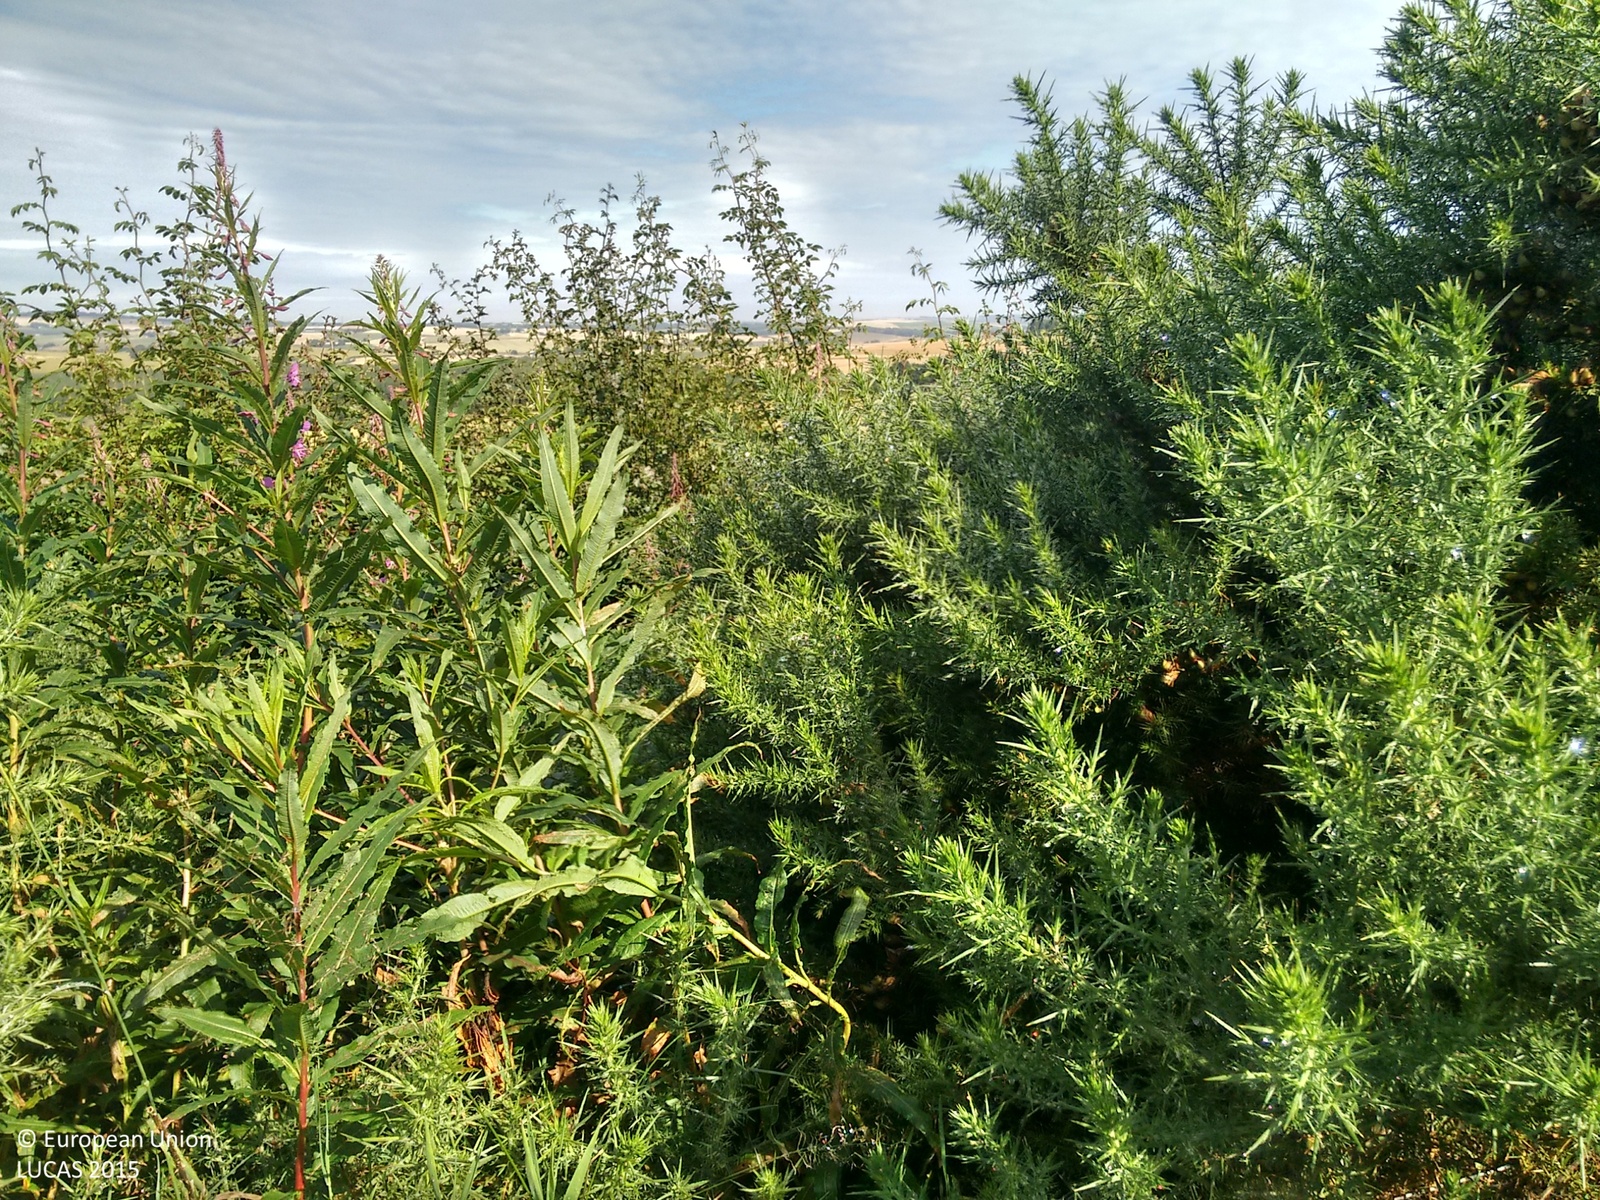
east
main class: Shrubland
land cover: Shrubland without tree cover
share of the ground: > 75 %
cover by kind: shrubs 100 %
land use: Agriculture (excluding fallow land and kitchen gardens)
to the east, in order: Shrubland without tree cover; Fences; Common wheat
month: August
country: GB
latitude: 57.4638
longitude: -2.1673
